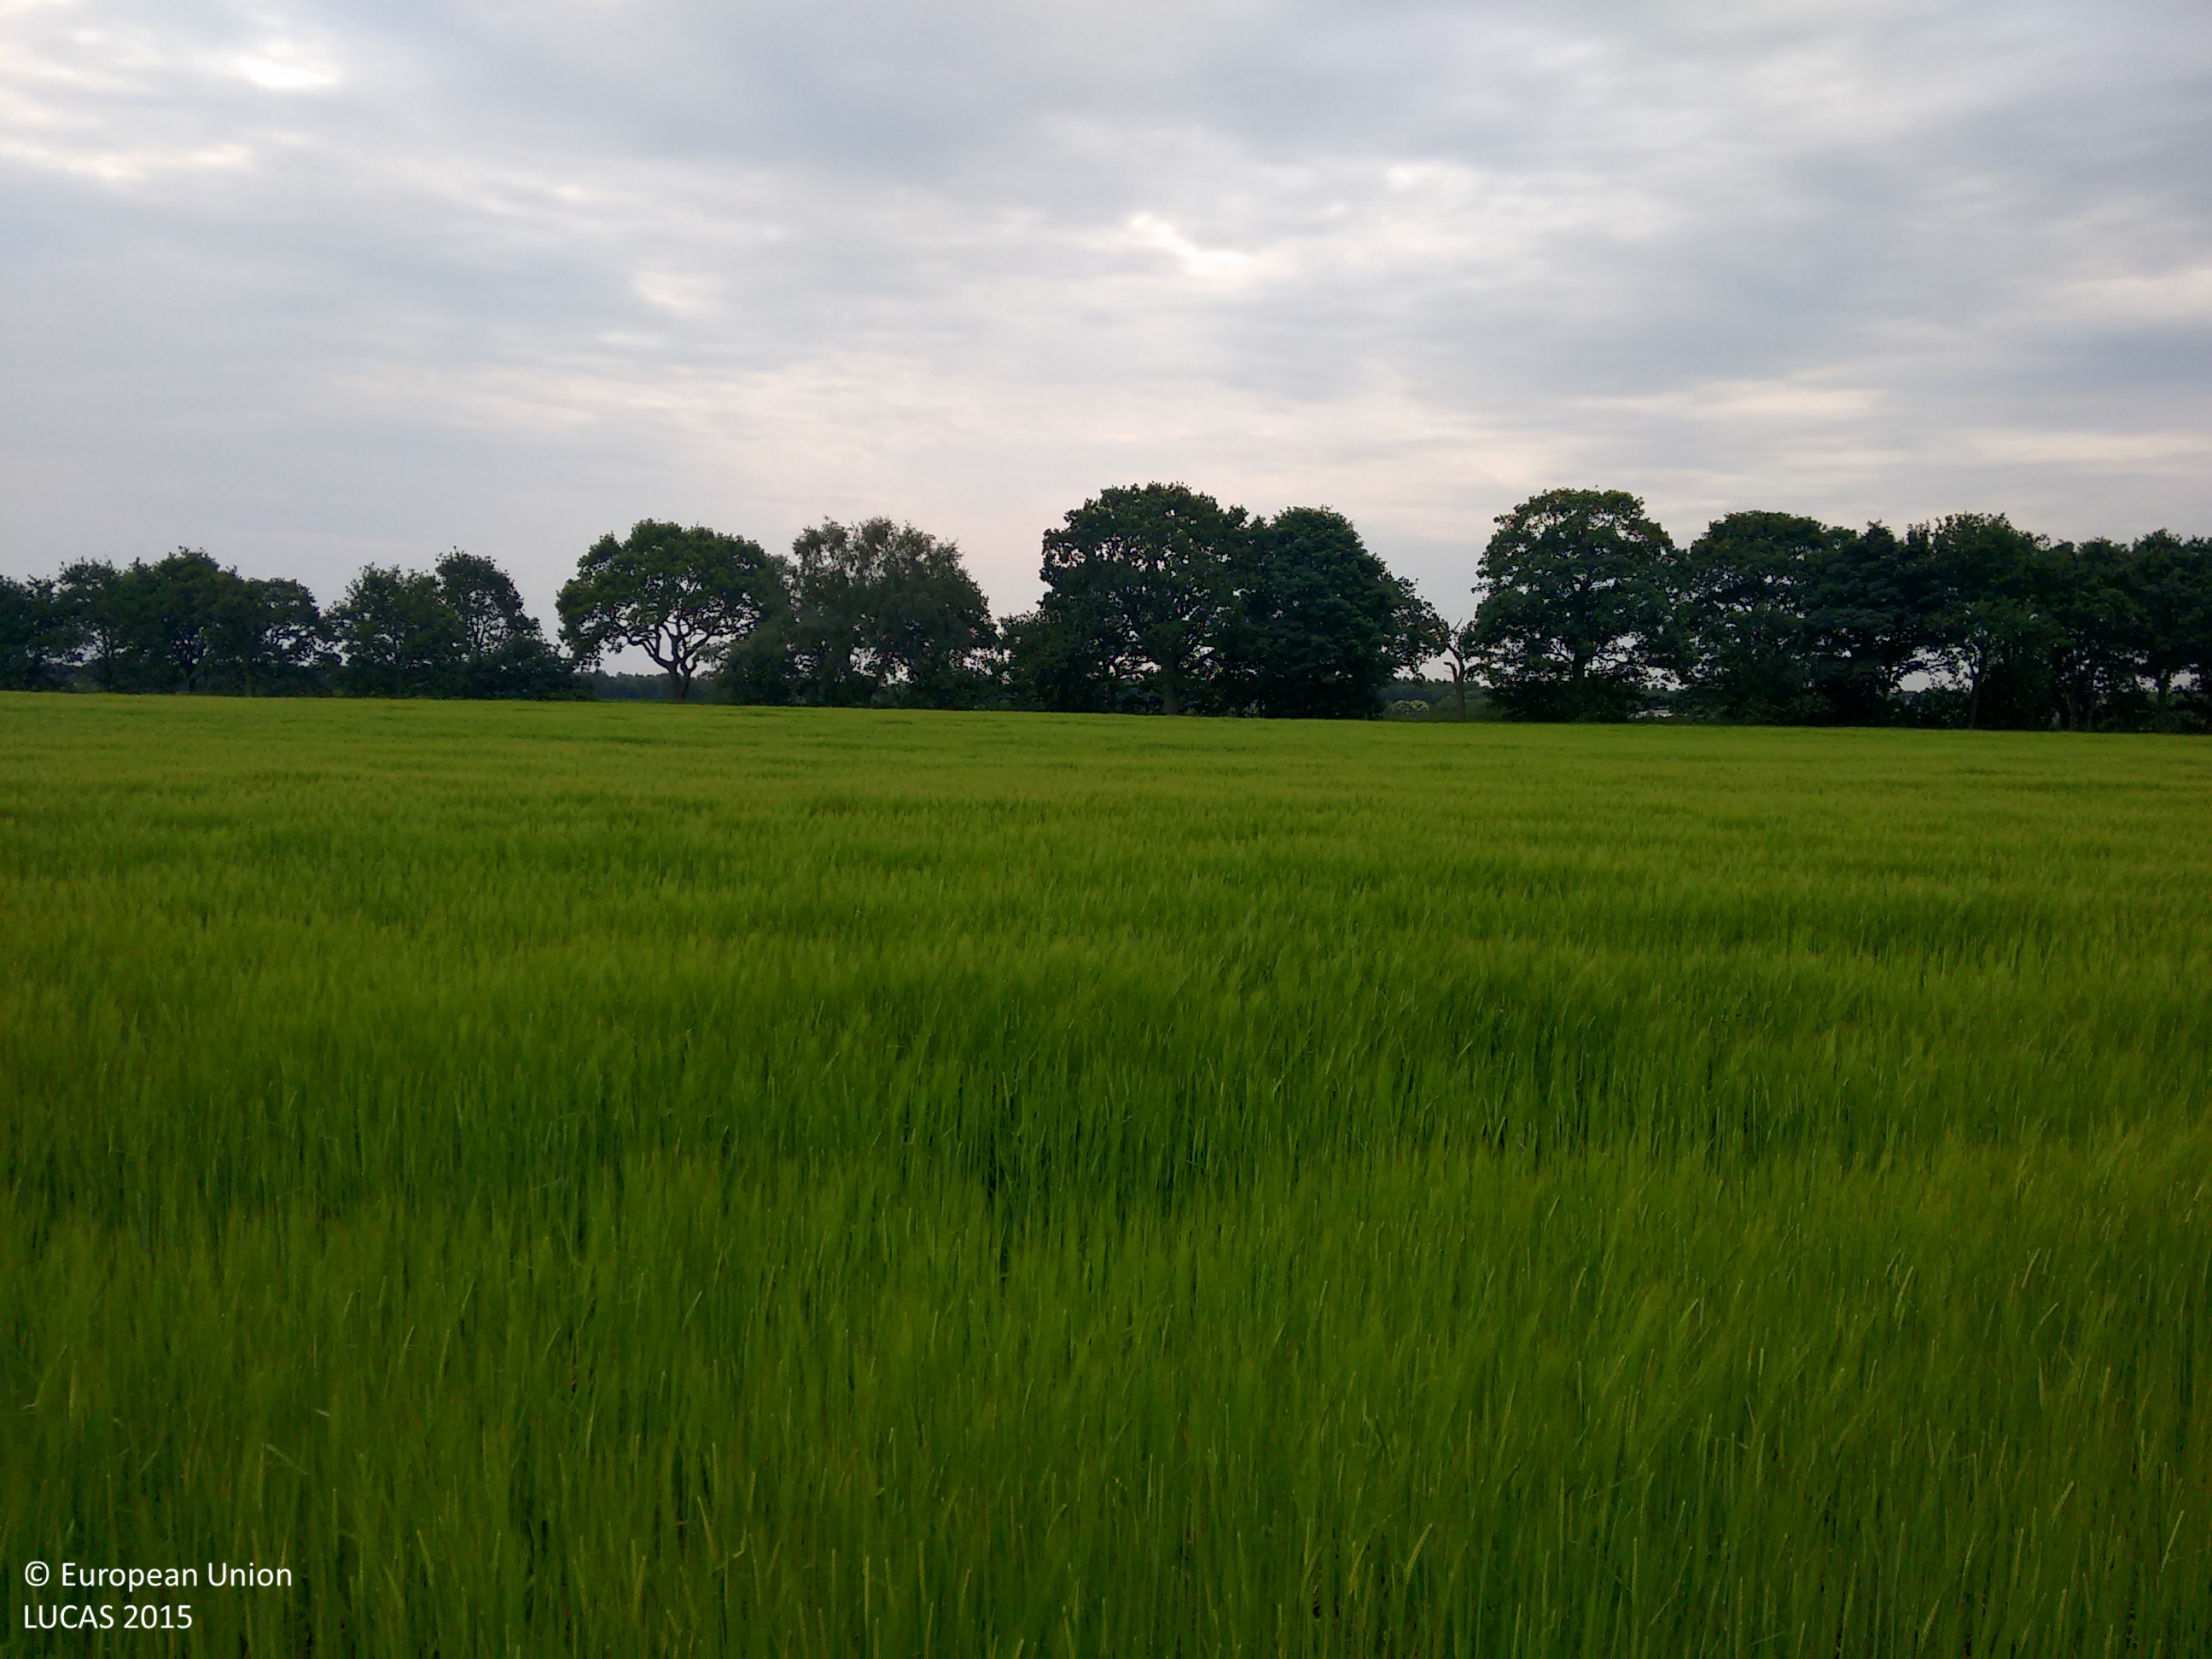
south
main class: Cropland
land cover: Barley
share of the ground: > 75 %
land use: Agriculture (excluding fallow land and kitchen gardens)
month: July
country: GB
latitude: 53.4826
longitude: -2.4670
